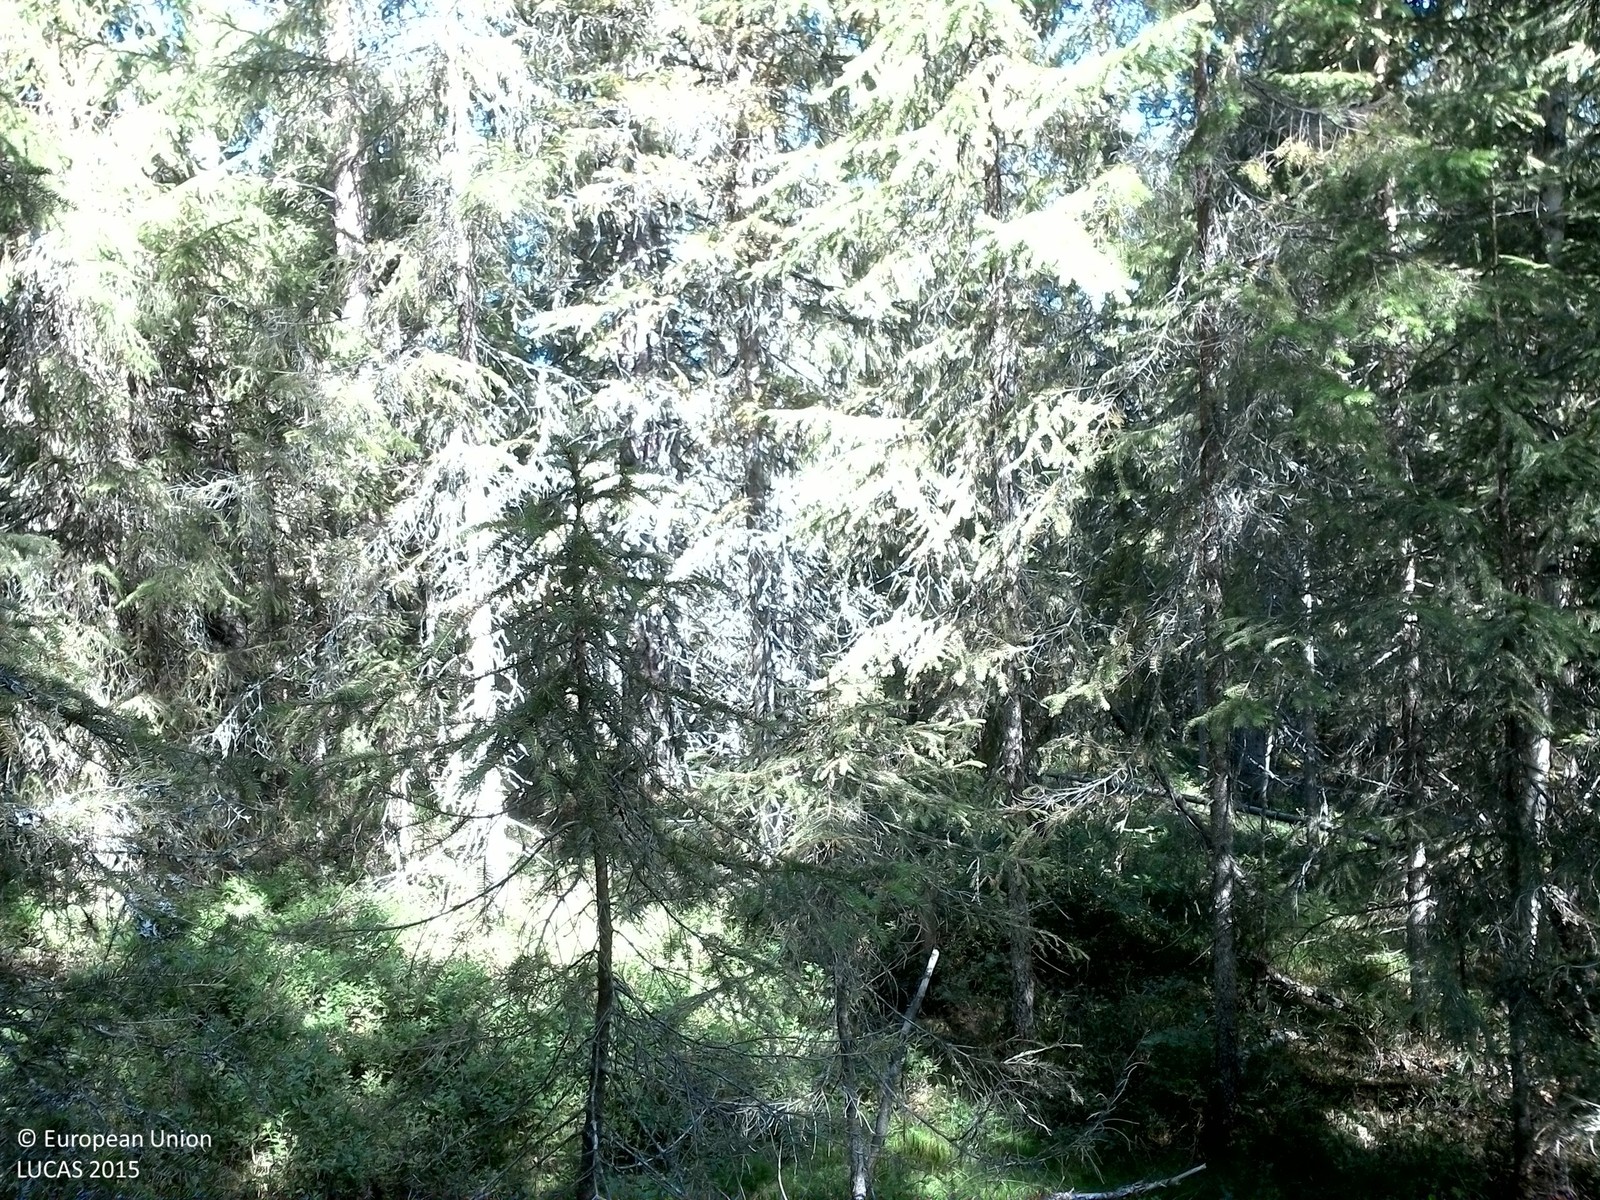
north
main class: Woodland
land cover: Spruce dominated coniferous woodland
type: boreal forest
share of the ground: > 75 %
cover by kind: coniferous forest trees 70 %, broadleaved forest trees 10 %, shrubs 10 %, lichens and mosses 10 %
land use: Forestry
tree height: > 5 m
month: August
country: SE
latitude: 63.6481
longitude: 17.7069
